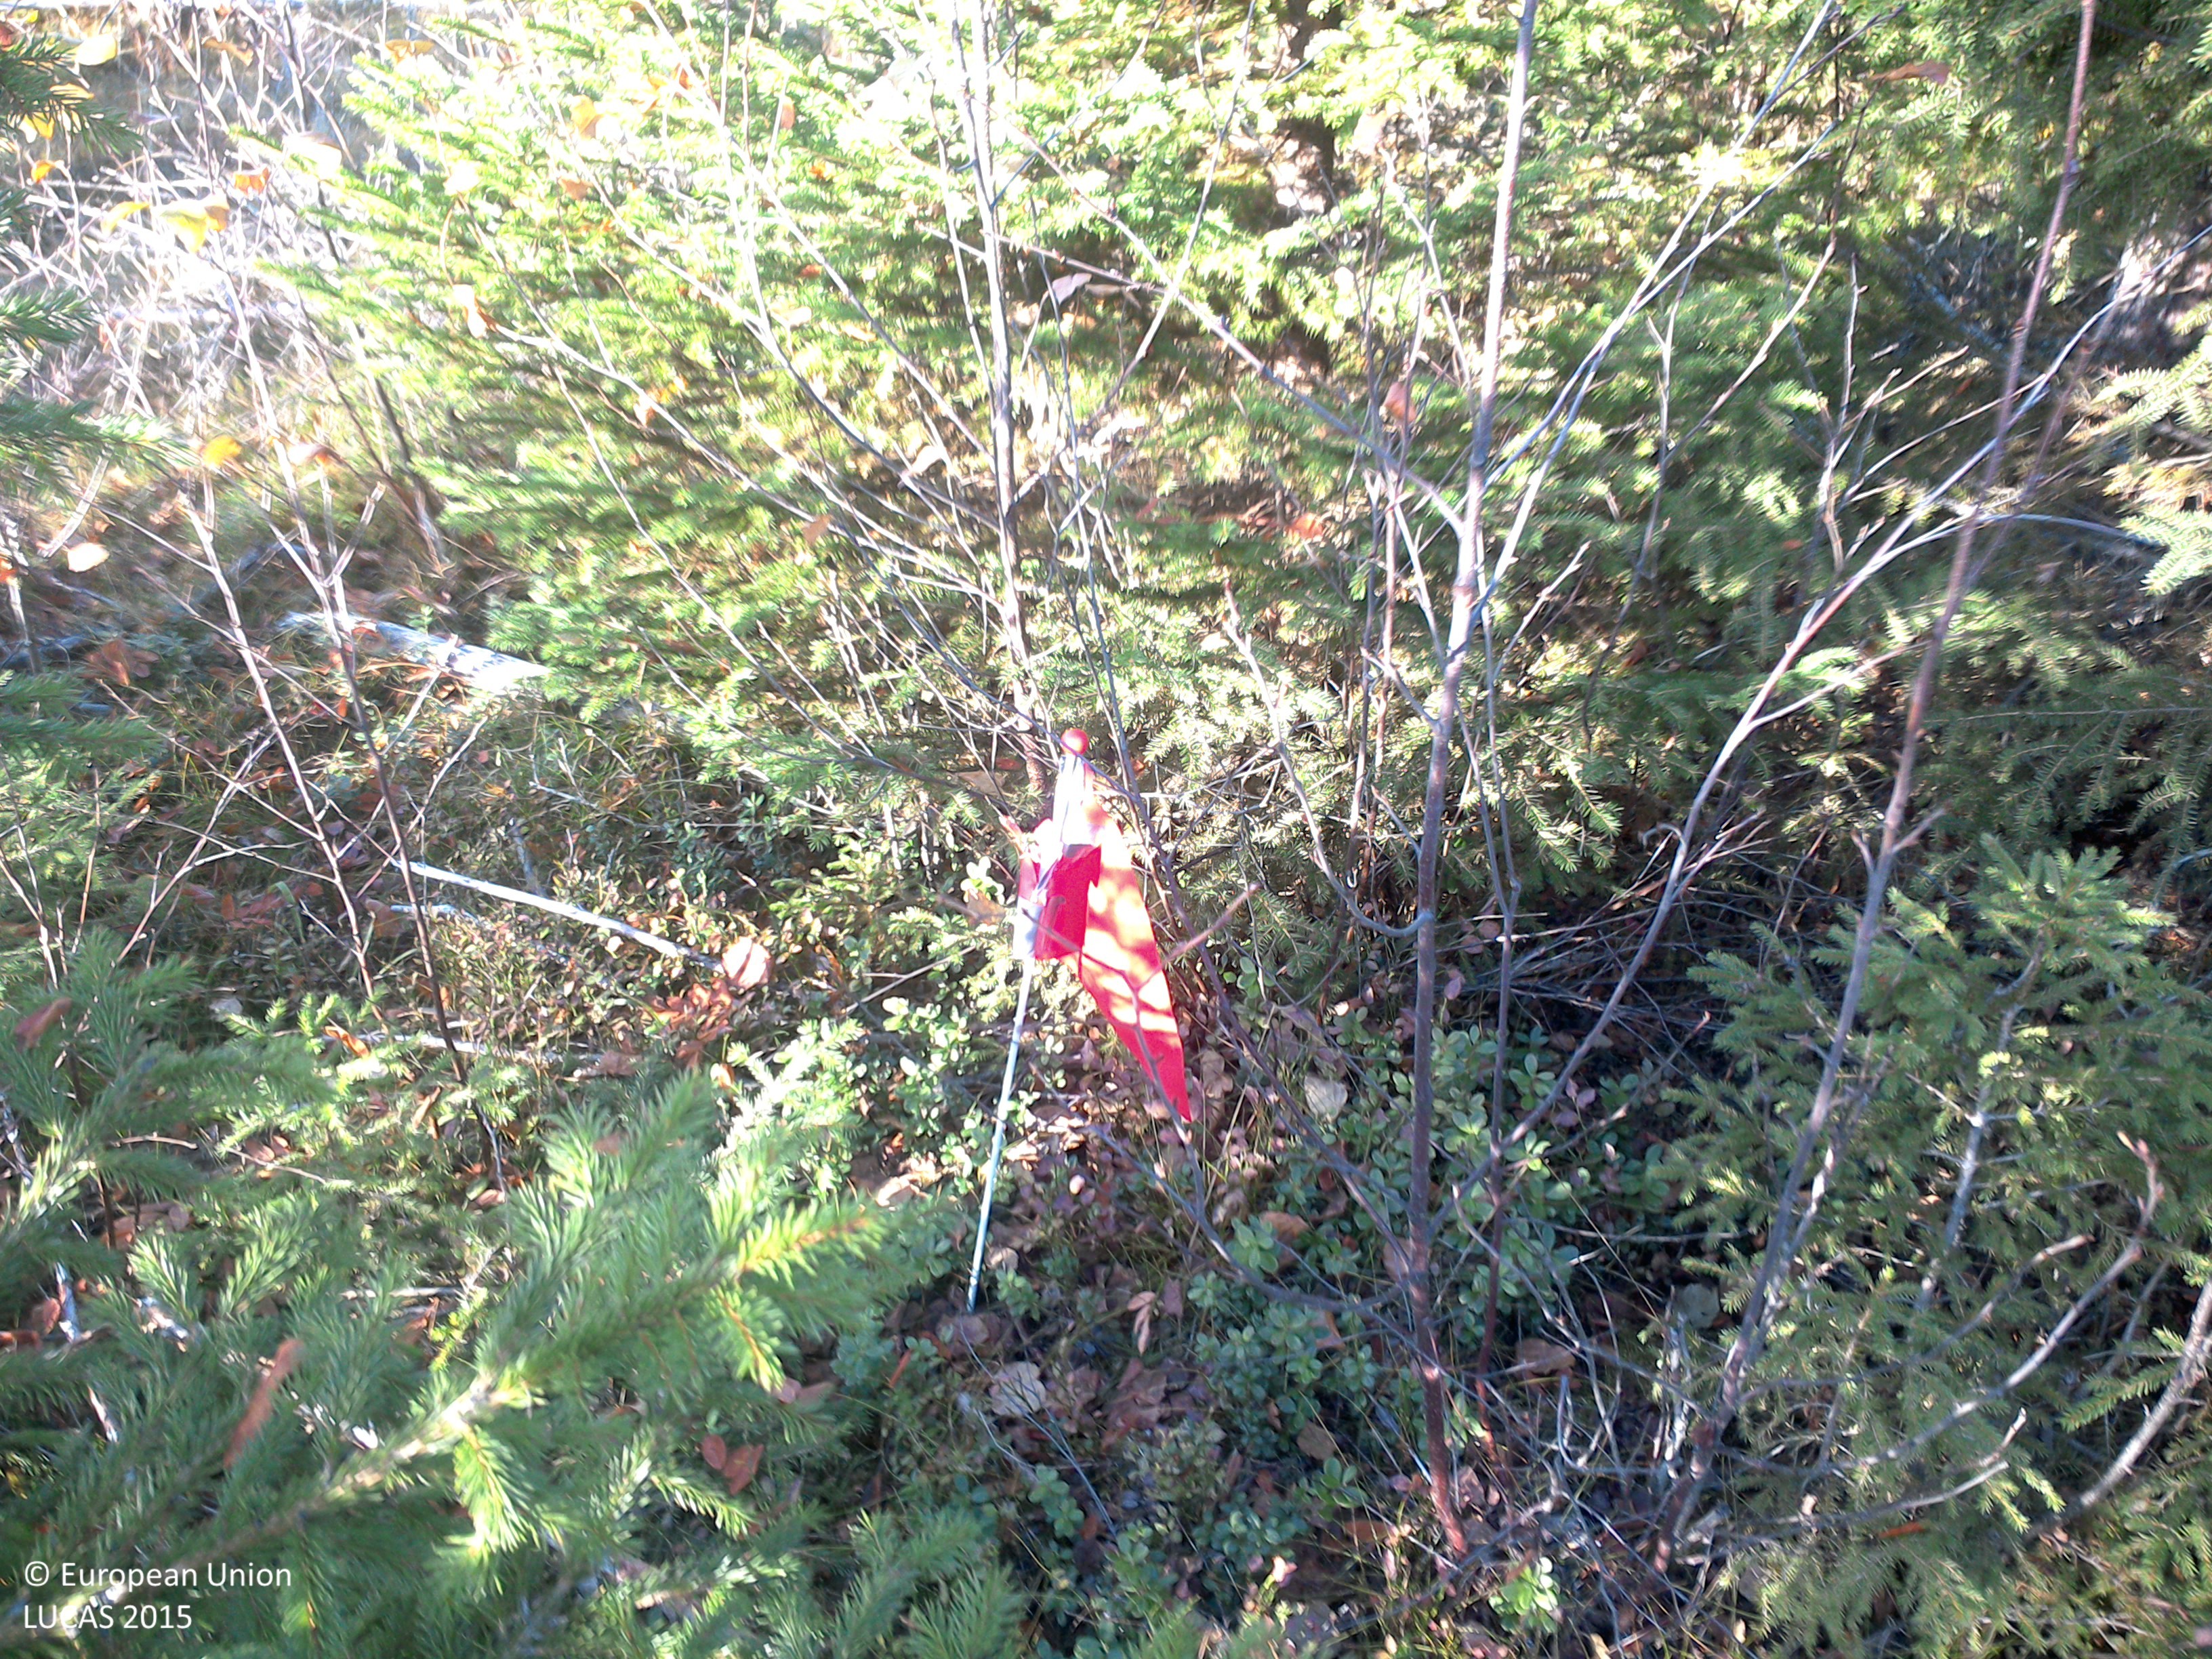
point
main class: Woodland
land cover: Spruce dominated mixed woodland
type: boreal forest
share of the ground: 25 - 50 %
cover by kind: shrubs 50 %, coniferous forest trees 30 %, broadleaved forest trees 20 %
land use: Forestry
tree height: > 5 m
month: October
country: SE
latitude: 63.8852
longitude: 19.6498
